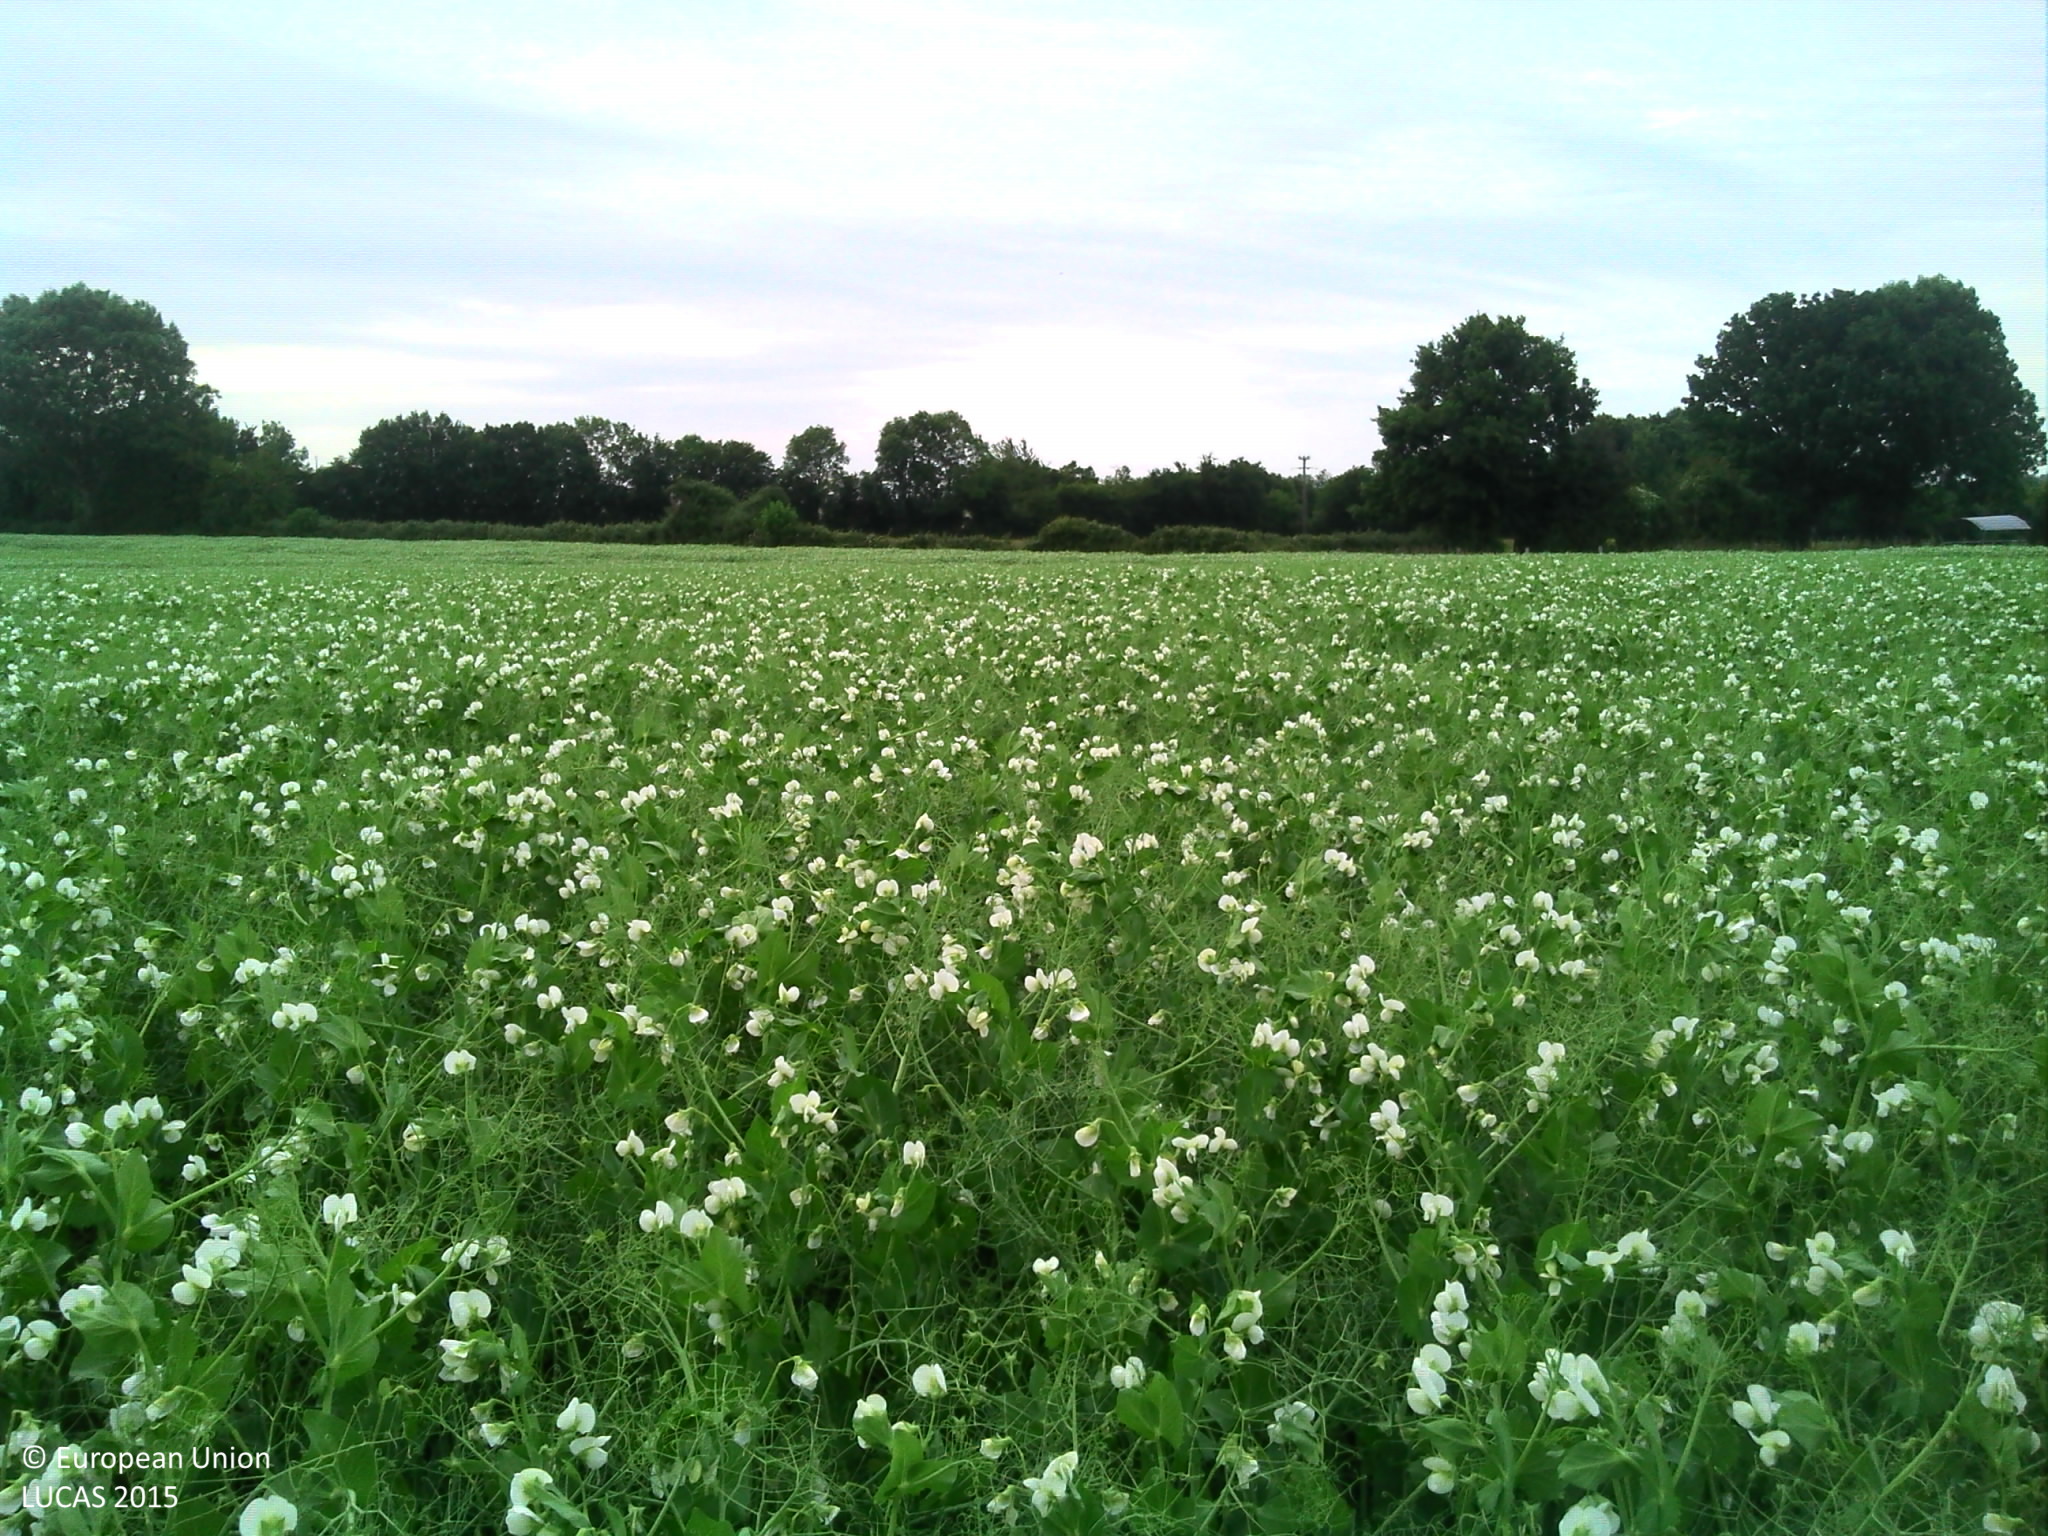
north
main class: Cropland
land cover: Dry pulses
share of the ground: > 75 %
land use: Agriculture (excluding fallow land and kitchen gardens)
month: June
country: FR
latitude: 48.5654
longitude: 0.2019
